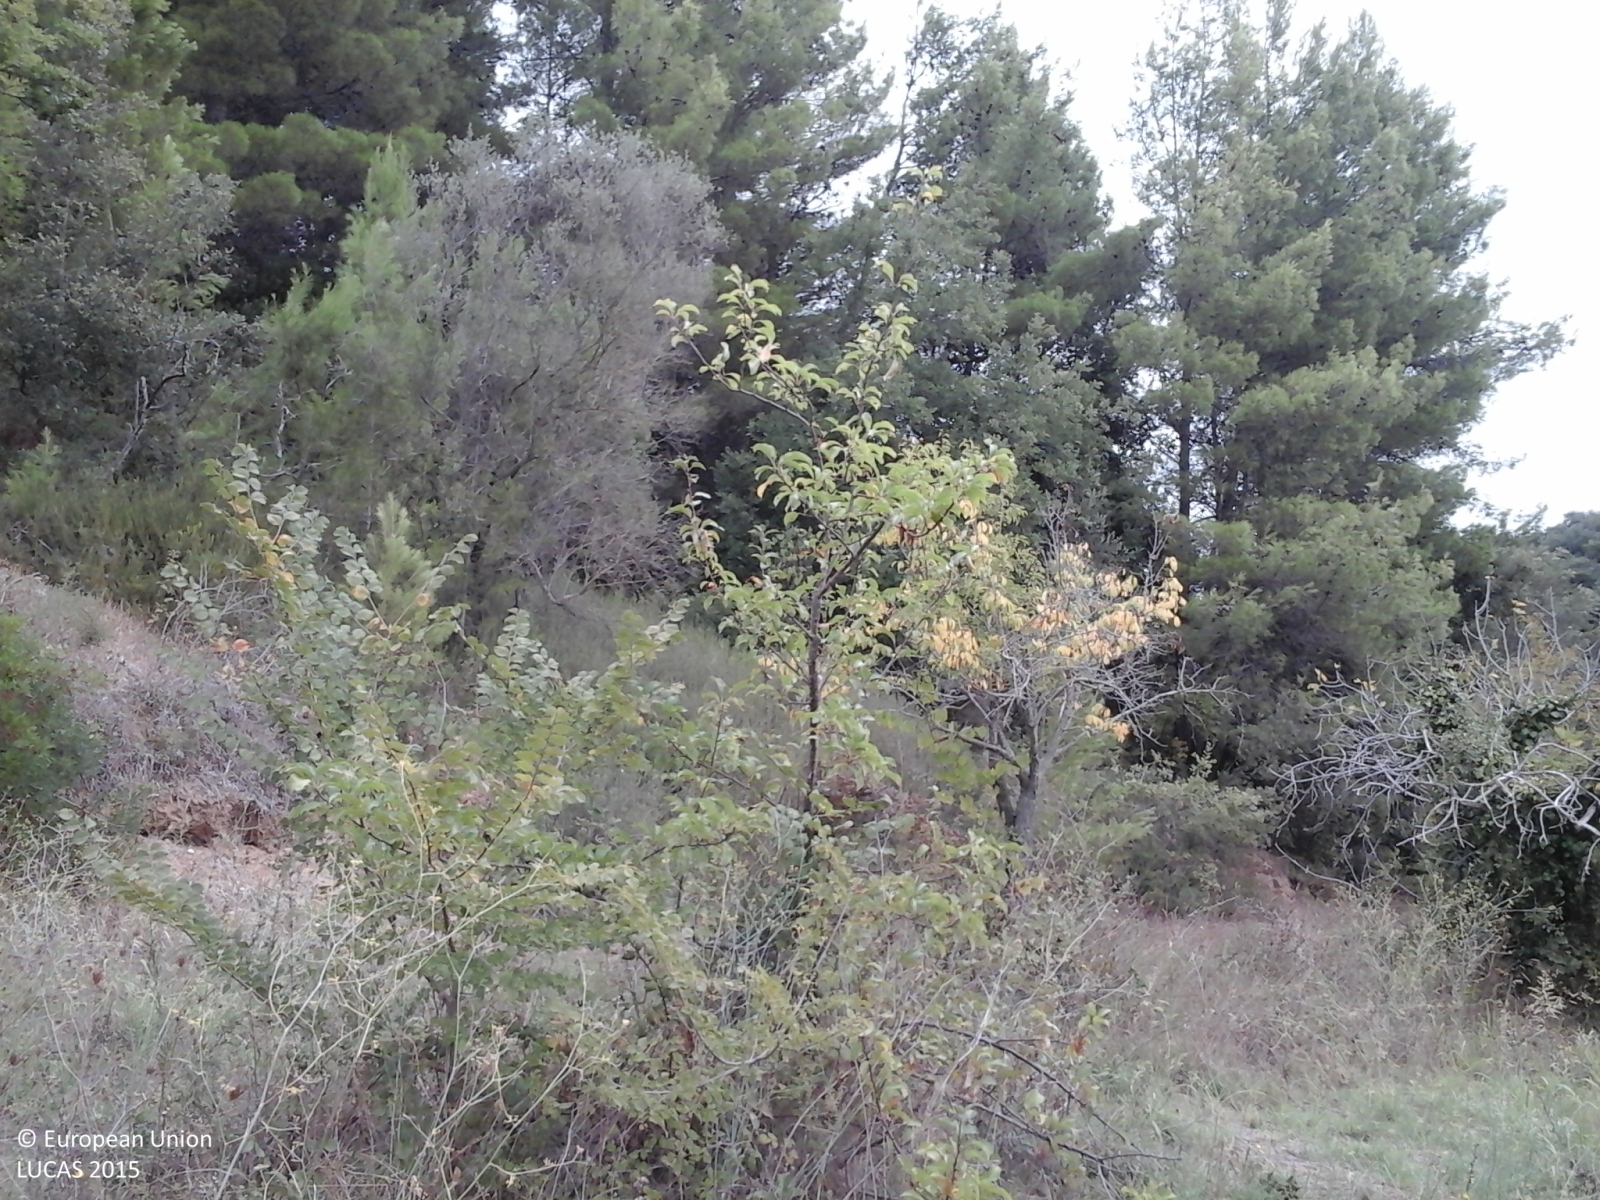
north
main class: Cropland
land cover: Apple fruit
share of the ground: > 75 %
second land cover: Spontaneously vegetated surfaces
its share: > 75 %
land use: Agriculture (excluding fallow land and kitchen gardens)
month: September
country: IT
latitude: 41.8520
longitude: 15.1754
